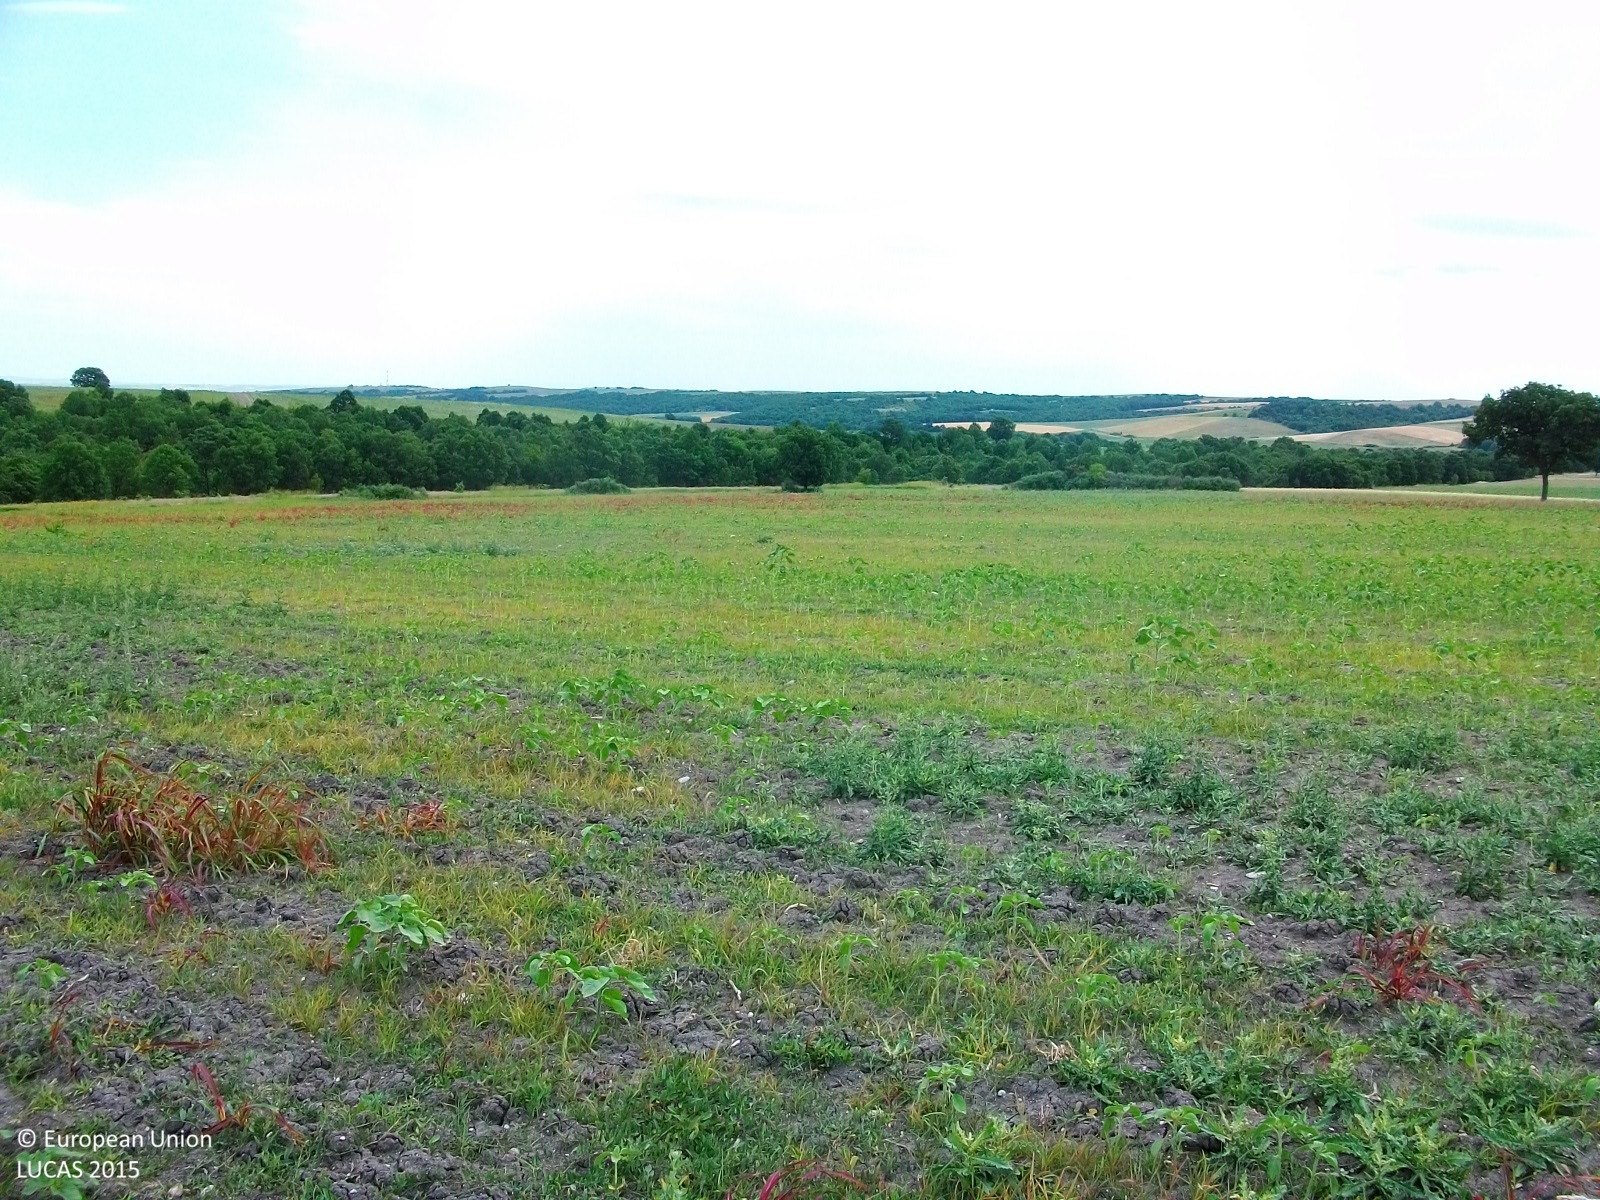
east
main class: Cropland
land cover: Sunflower
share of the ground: < 10 %
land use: Agriculture (excluding fallow land and kitchen gardens)
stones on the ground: < 10 %
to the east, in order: Sunflower; Durum wheat; Grassland with sparse tree/shrub cover; Tracks; Broadleaved woodland
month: June
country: GR
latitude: 41.6913
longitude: 26.1864
